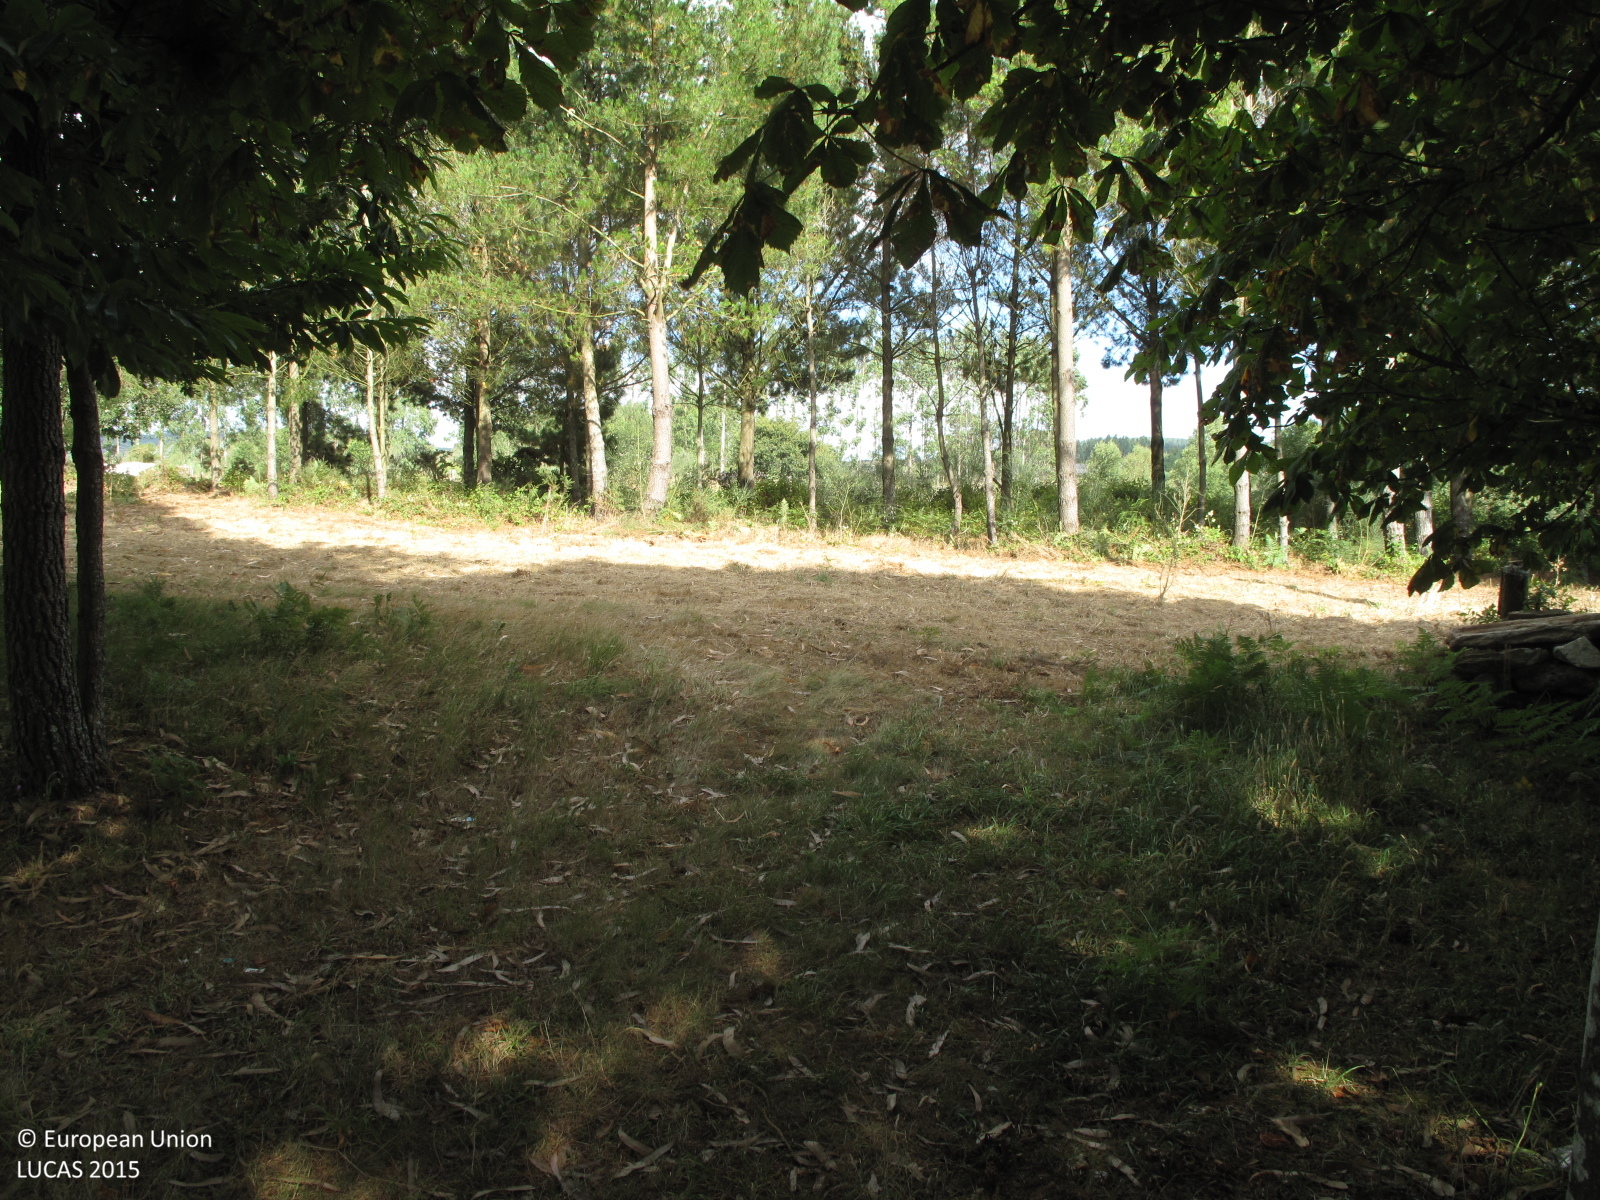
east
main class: Woodland
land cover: Other coniferous woodland
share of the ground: > 75 %
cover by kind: coniferous forest trees 80 %, shrubs 20 %
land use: Community services
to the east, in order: Other coniferous woodland; Dry stone walls; Electric lines; Grassland without tree/shrub cover; Pine dominated coniferous woodland; Fences; Potatoes; Fences; Grassland without tree/shrub cover; Shrubland with sparse tree cover; Grassland without tree/shrub cover; Paved roads, cycling and walking lanes; Shrubland with sparse tree cover; Grassland without tree/shrub cover; Broadleaved woodland; Paved roads, cycling and walking lanes; Broadleaved woodland
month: July
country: ES
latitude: 43.0810
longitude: -7.9613
